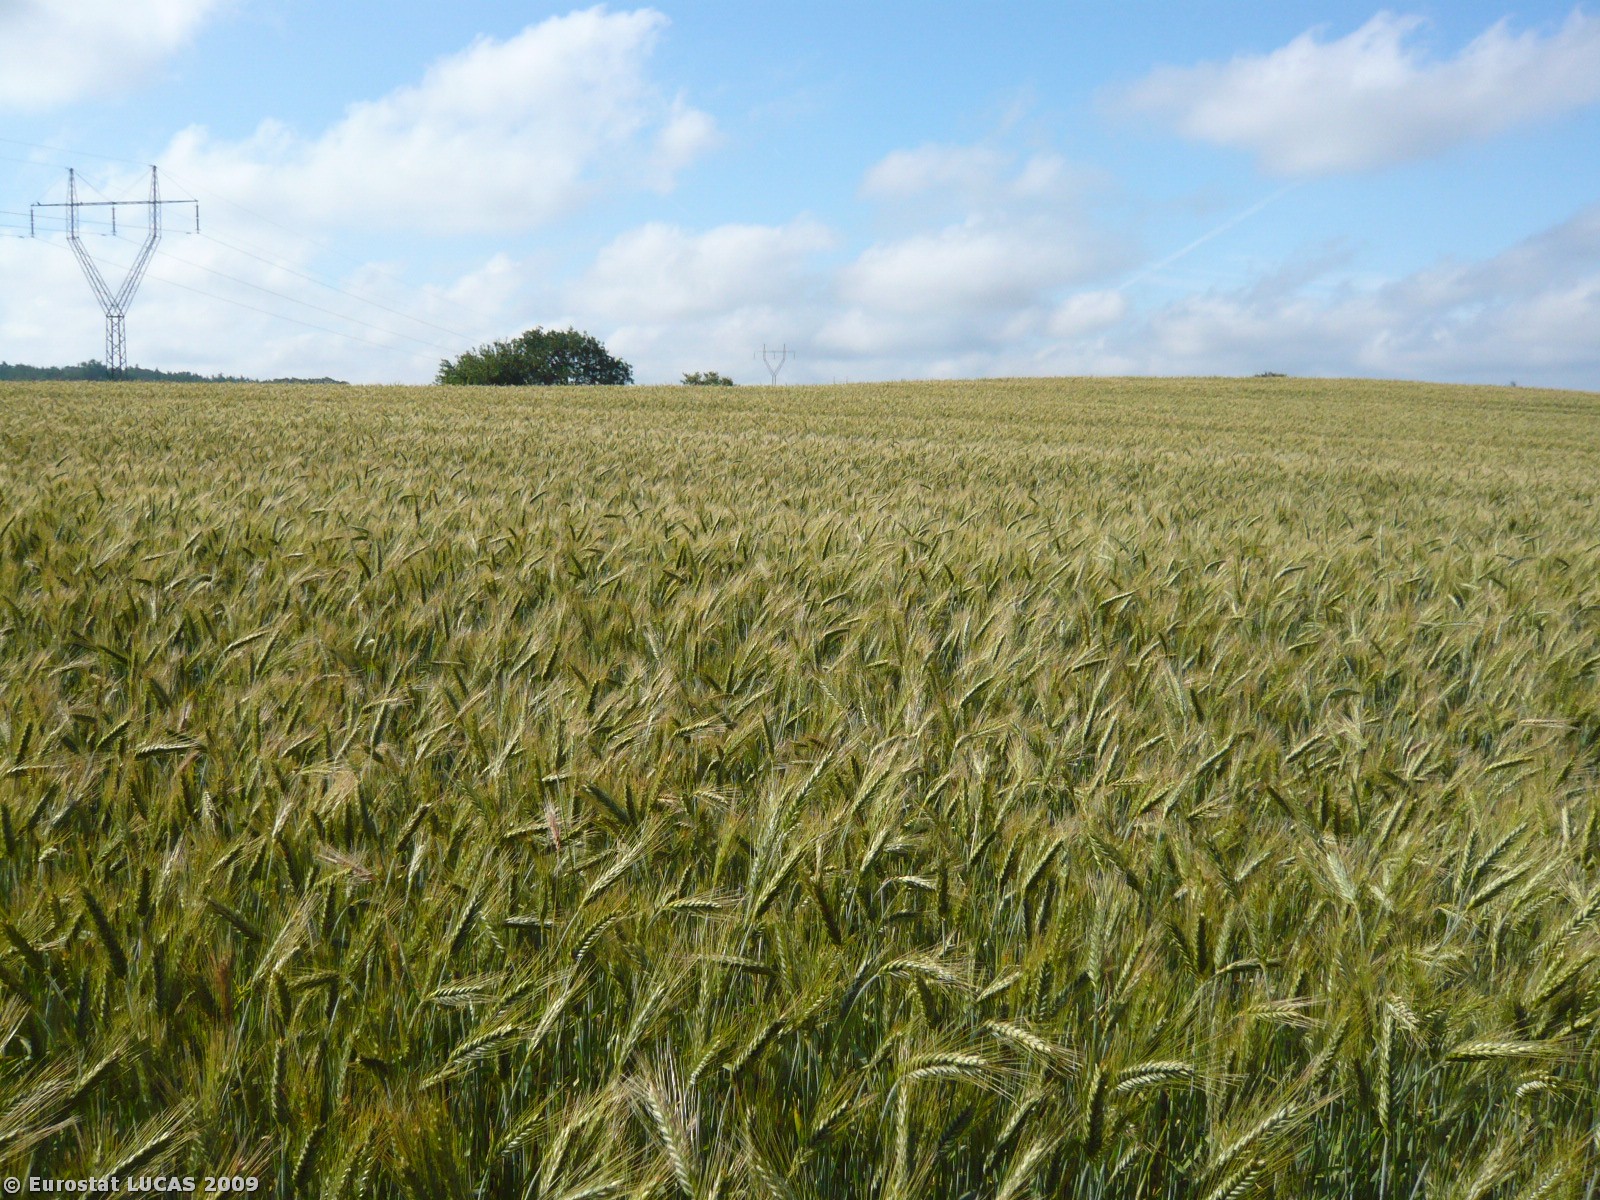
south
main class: Cropland
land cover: Triticale
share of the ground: > 75 %
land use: Agriculture (excluding fallow land and kitchen gardens)
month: June
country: DK
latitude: 55.2170
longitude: 10.1728
